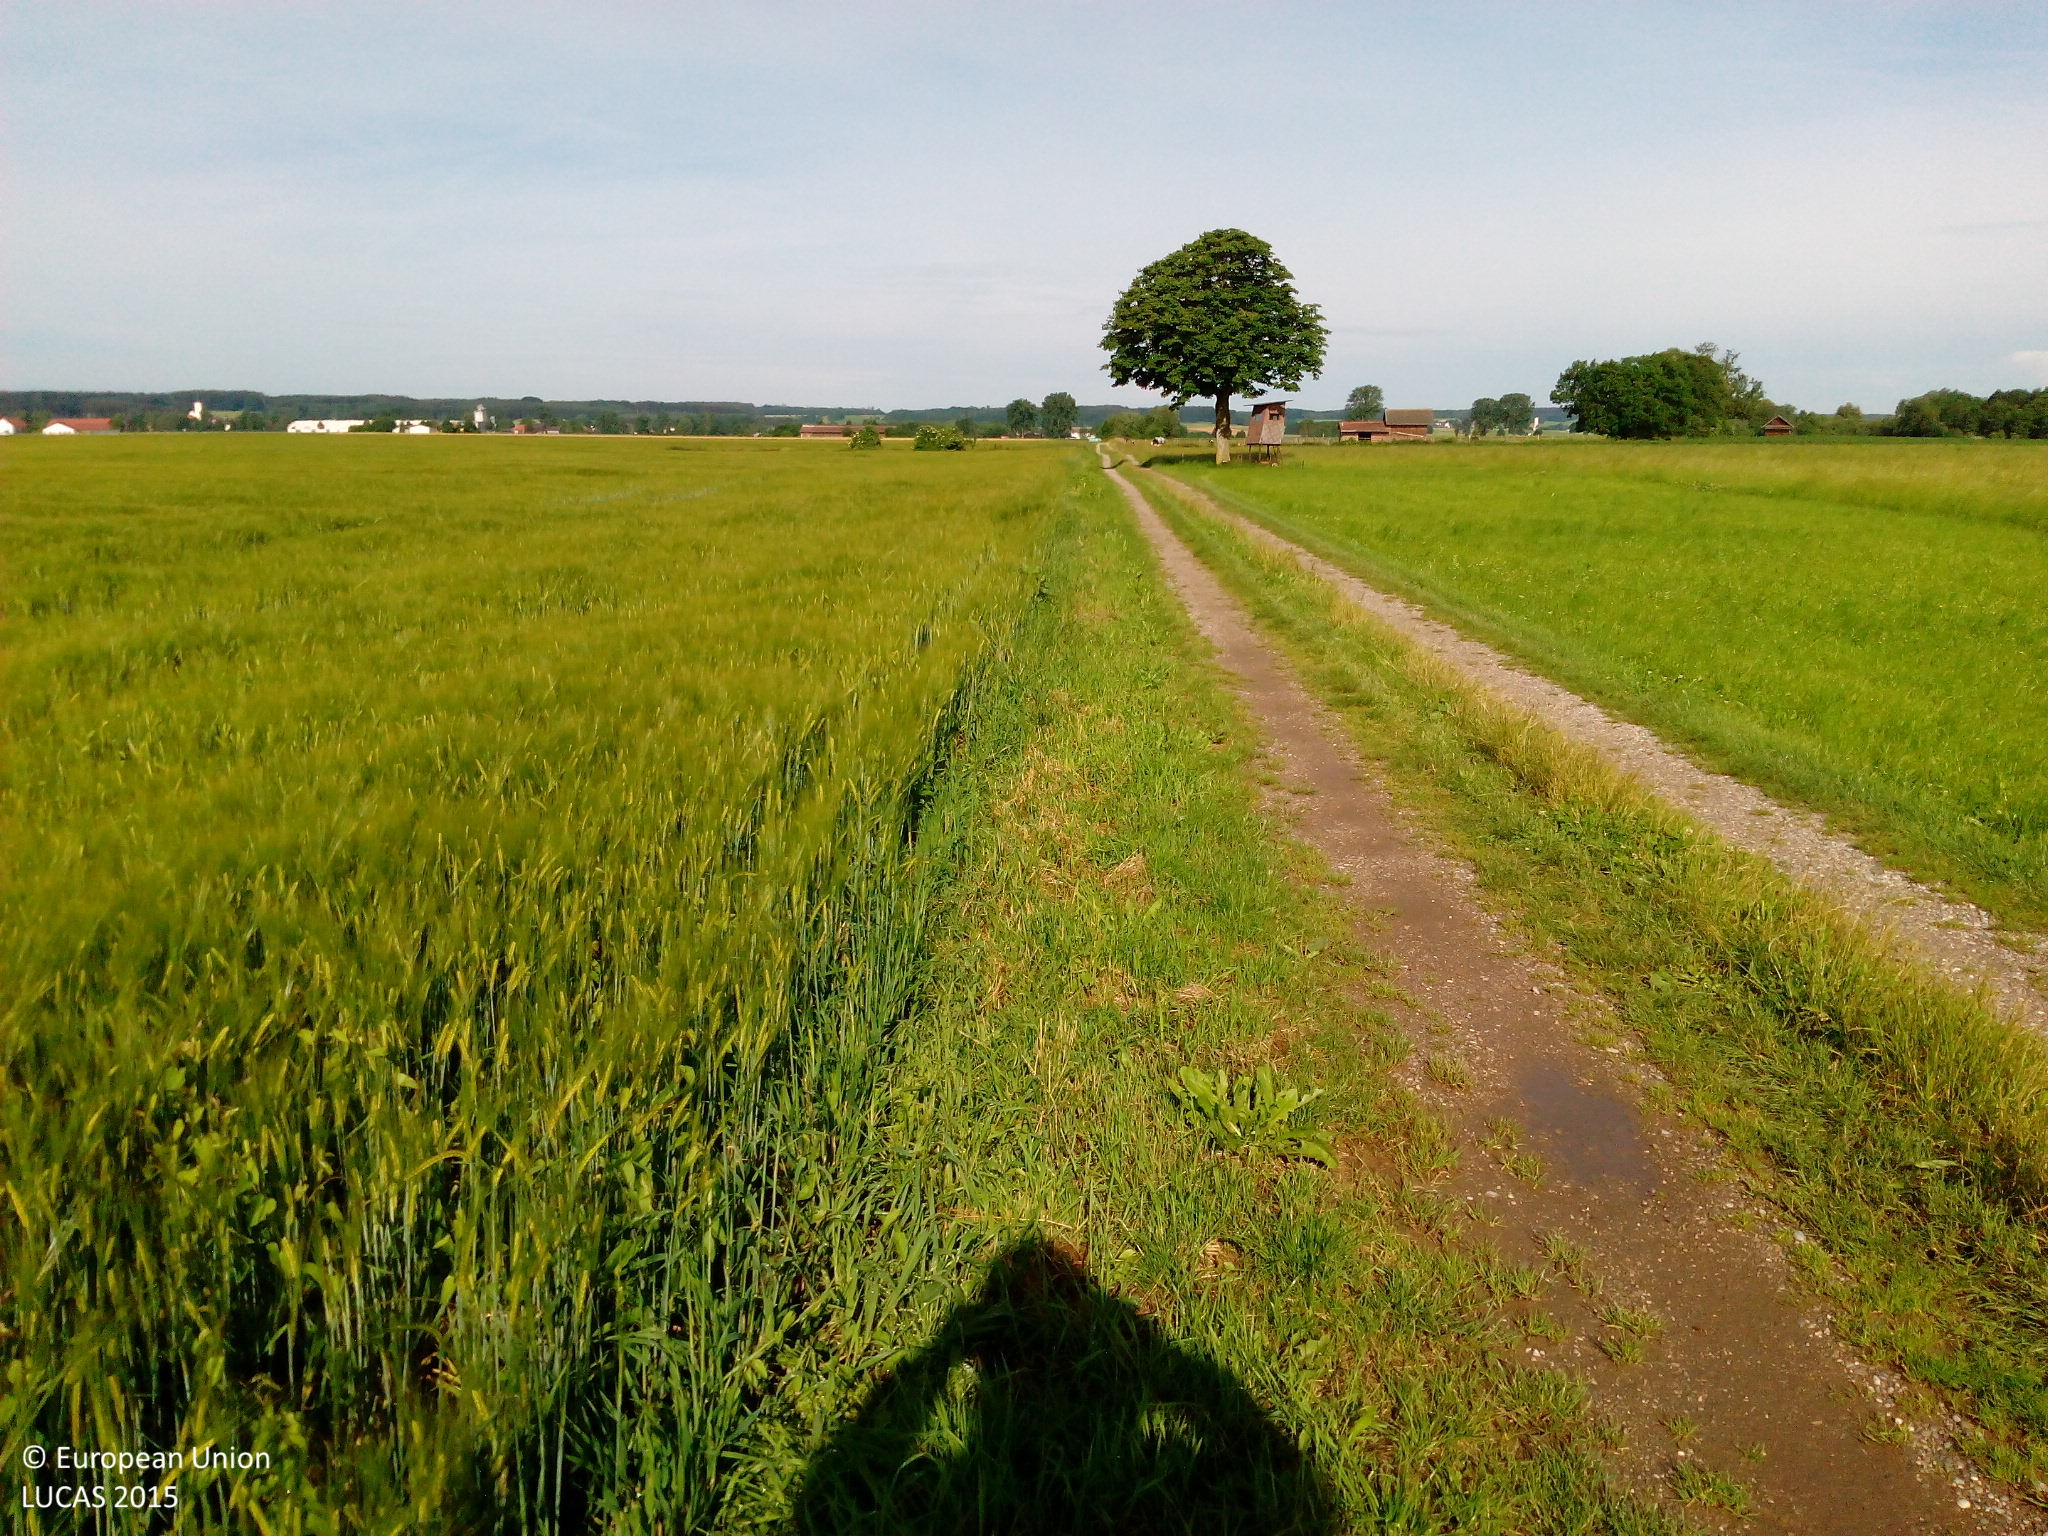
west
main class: Cropland
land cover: Barley
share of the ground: > 75 %
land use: Agriculture (excluding fallow land and kitchen gardens)
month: June
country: DE
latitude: 48.0779
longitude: 10.6036
